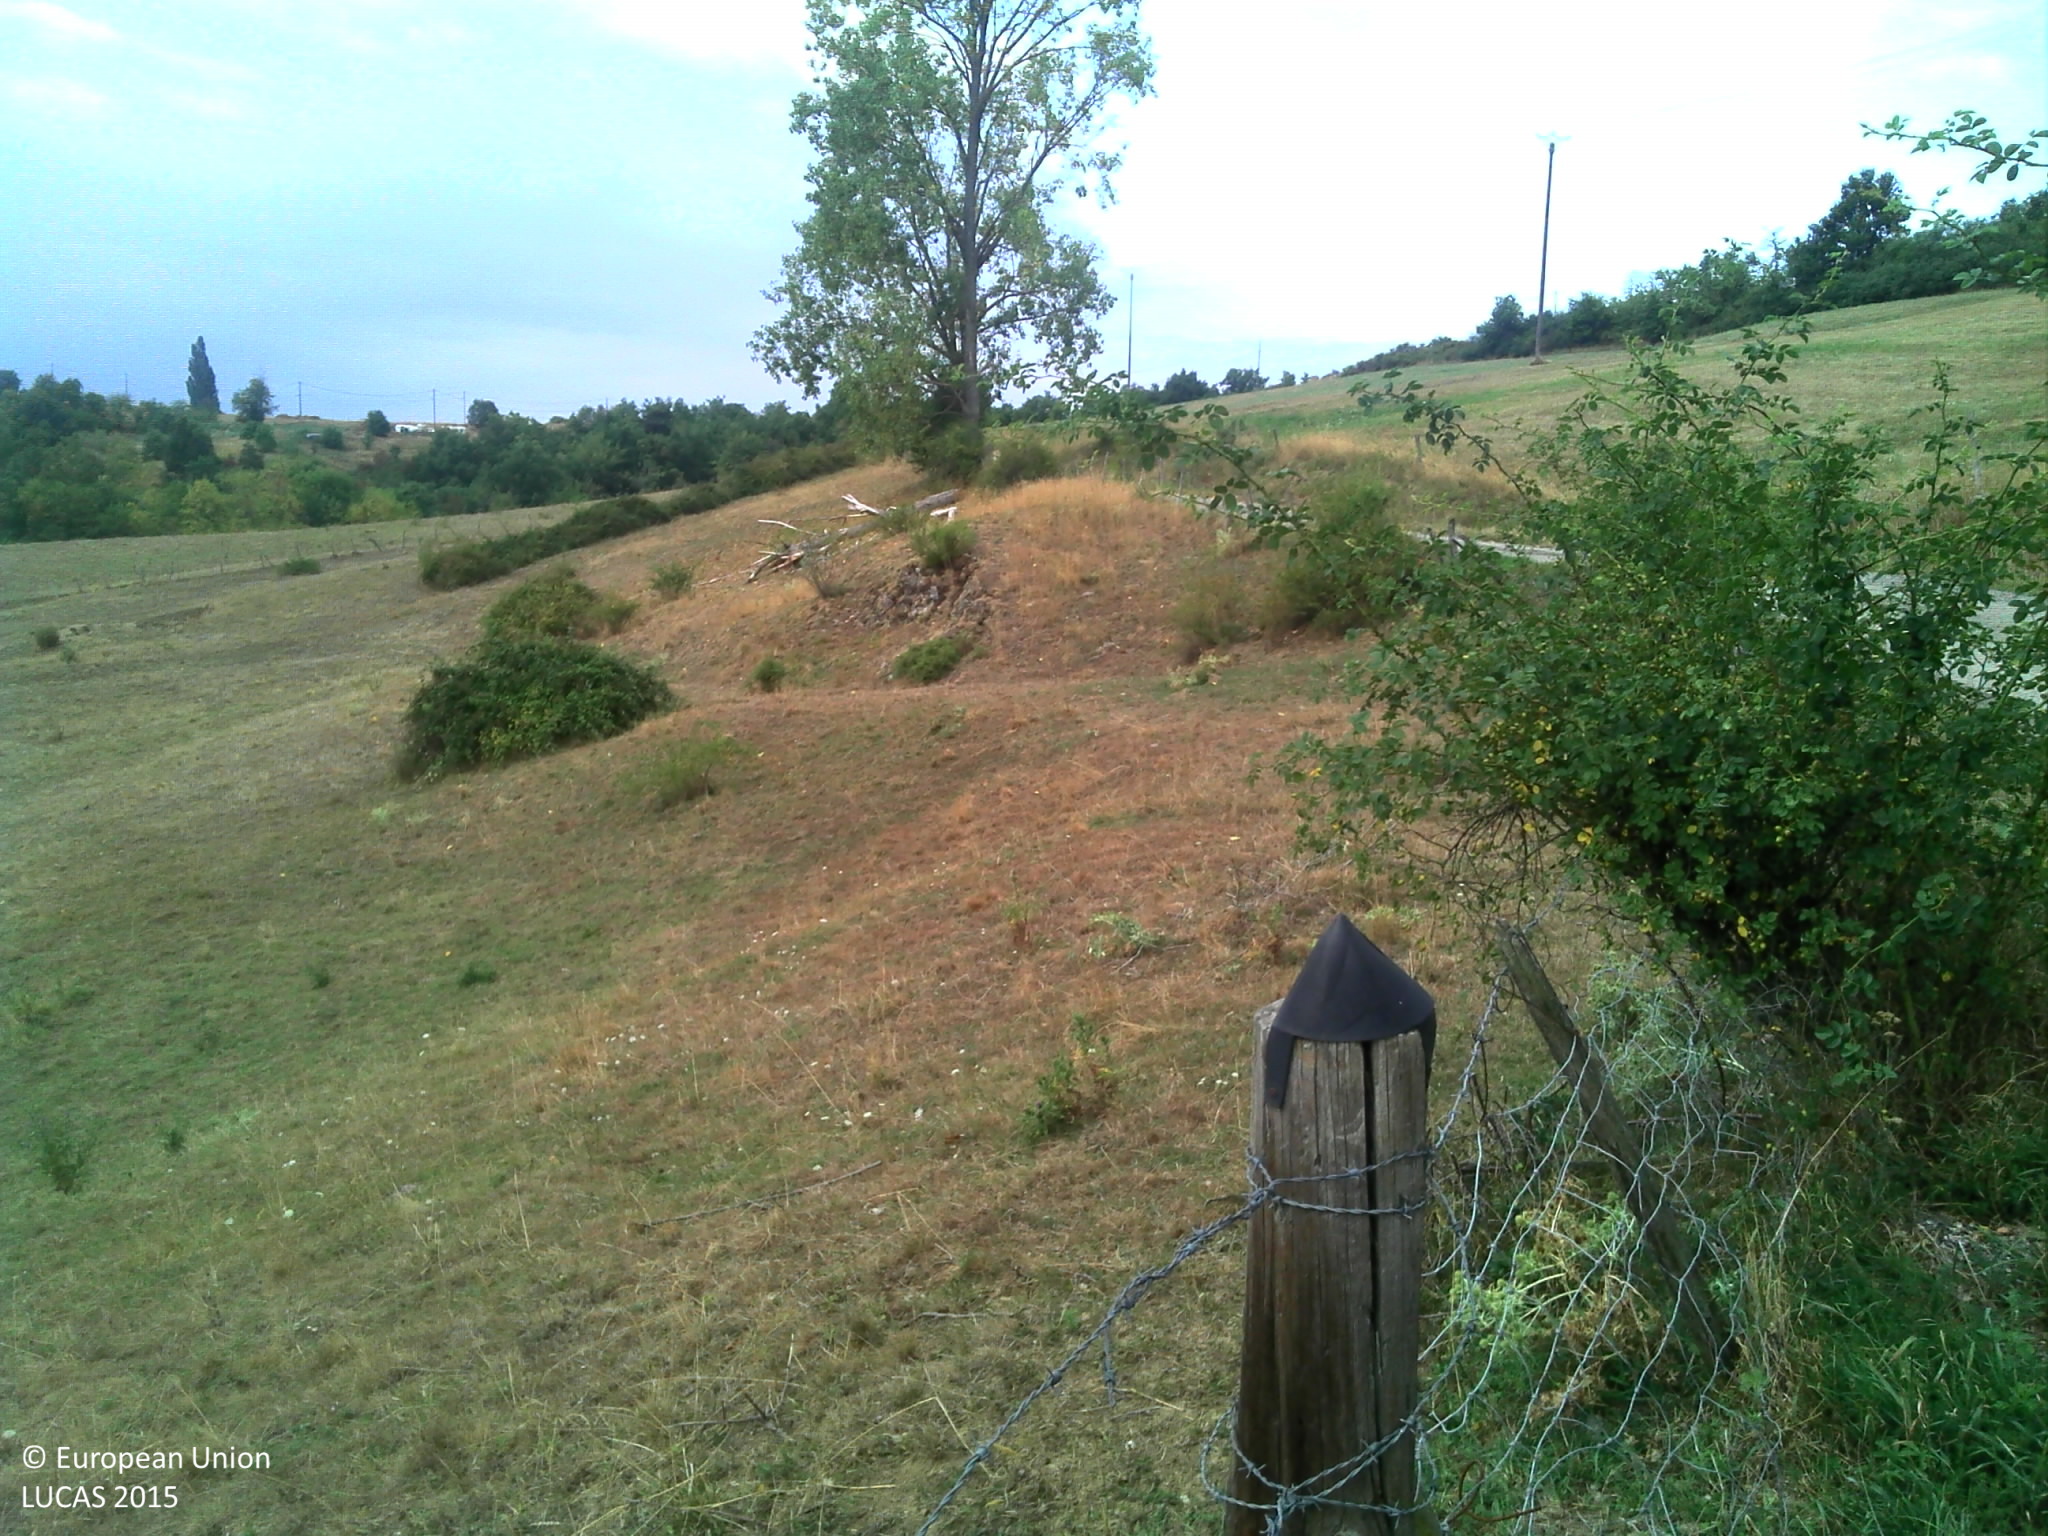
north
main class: Grassland
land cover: Grassland with sparse tree/shrub cover
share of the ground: > 75 %
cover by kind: herbaceous plants 95 %, coniferous forest trees 5 %
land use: Agriculture (excluding fallow land and kitchen gardens)
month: August
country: FR
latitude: 45.0134
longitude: 4.7649
